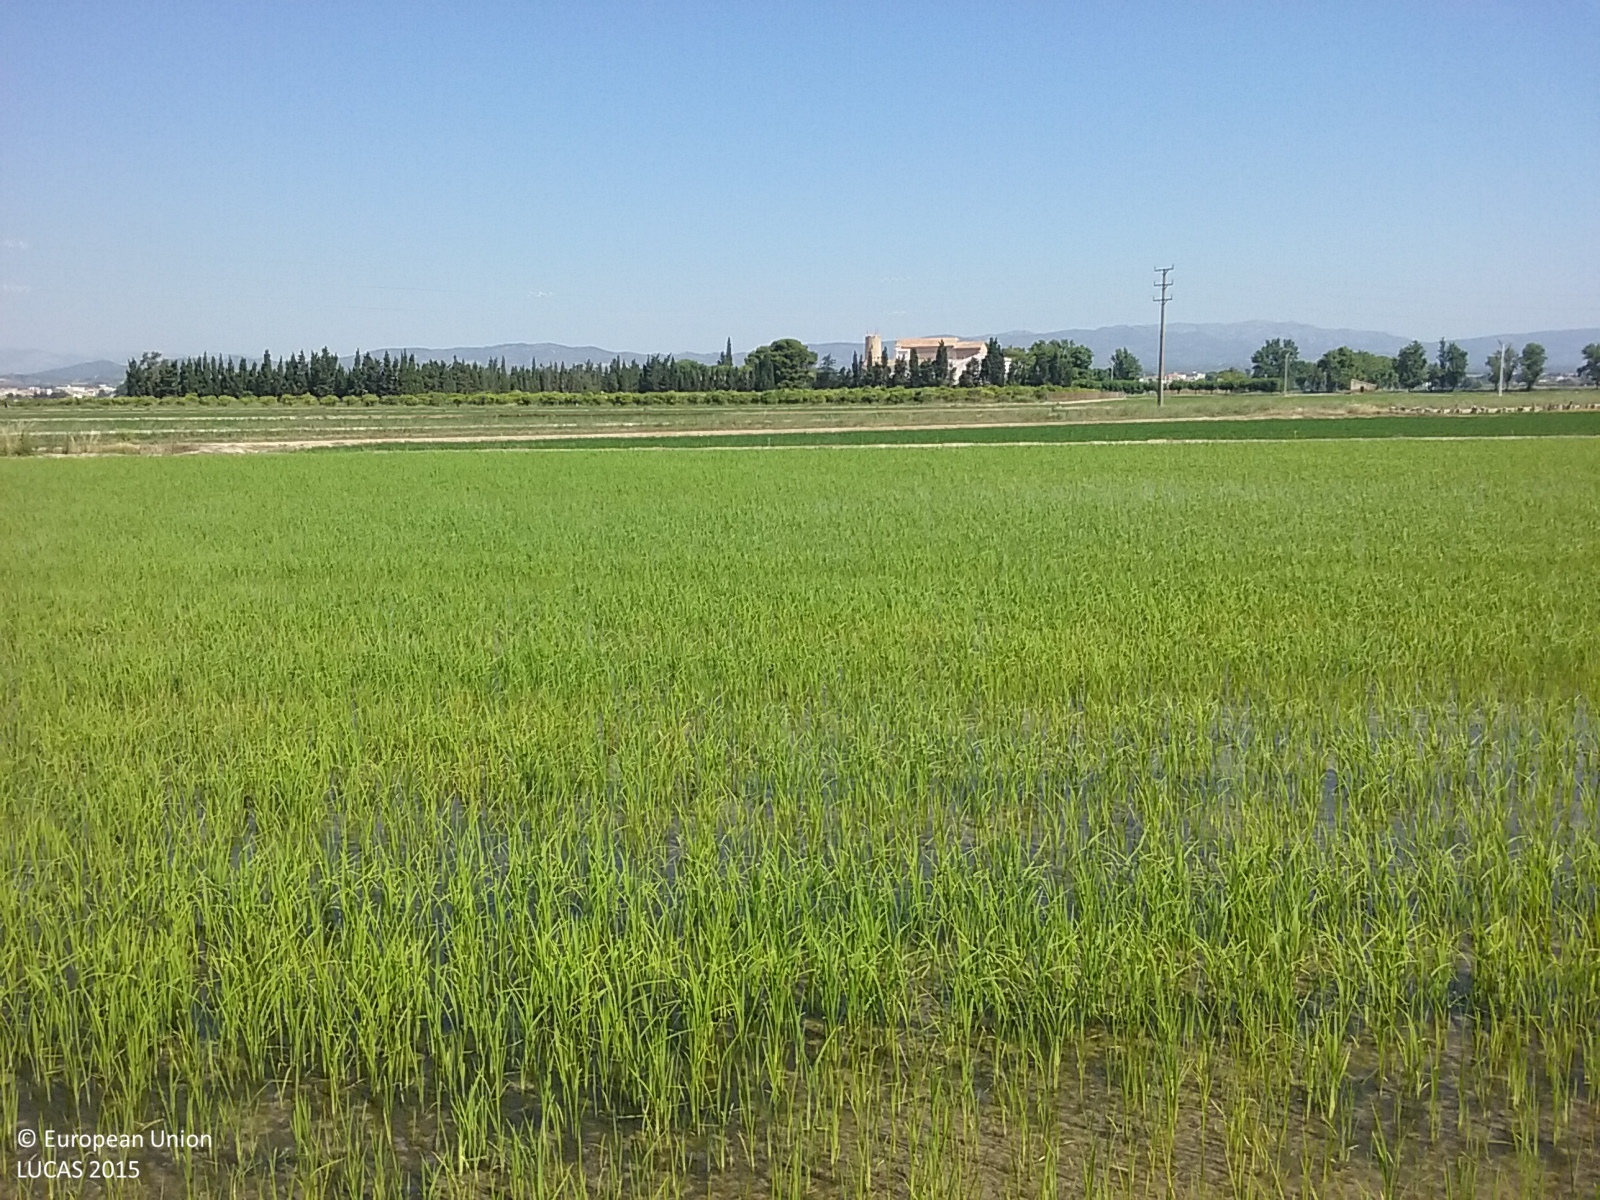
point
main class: Cropland
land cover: Rice
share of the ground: 50 - 75 %
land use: Agriculture (excluding fallow land and kitchen gardens)
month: June
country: ES
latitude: 40.7279
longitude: 0.6296
